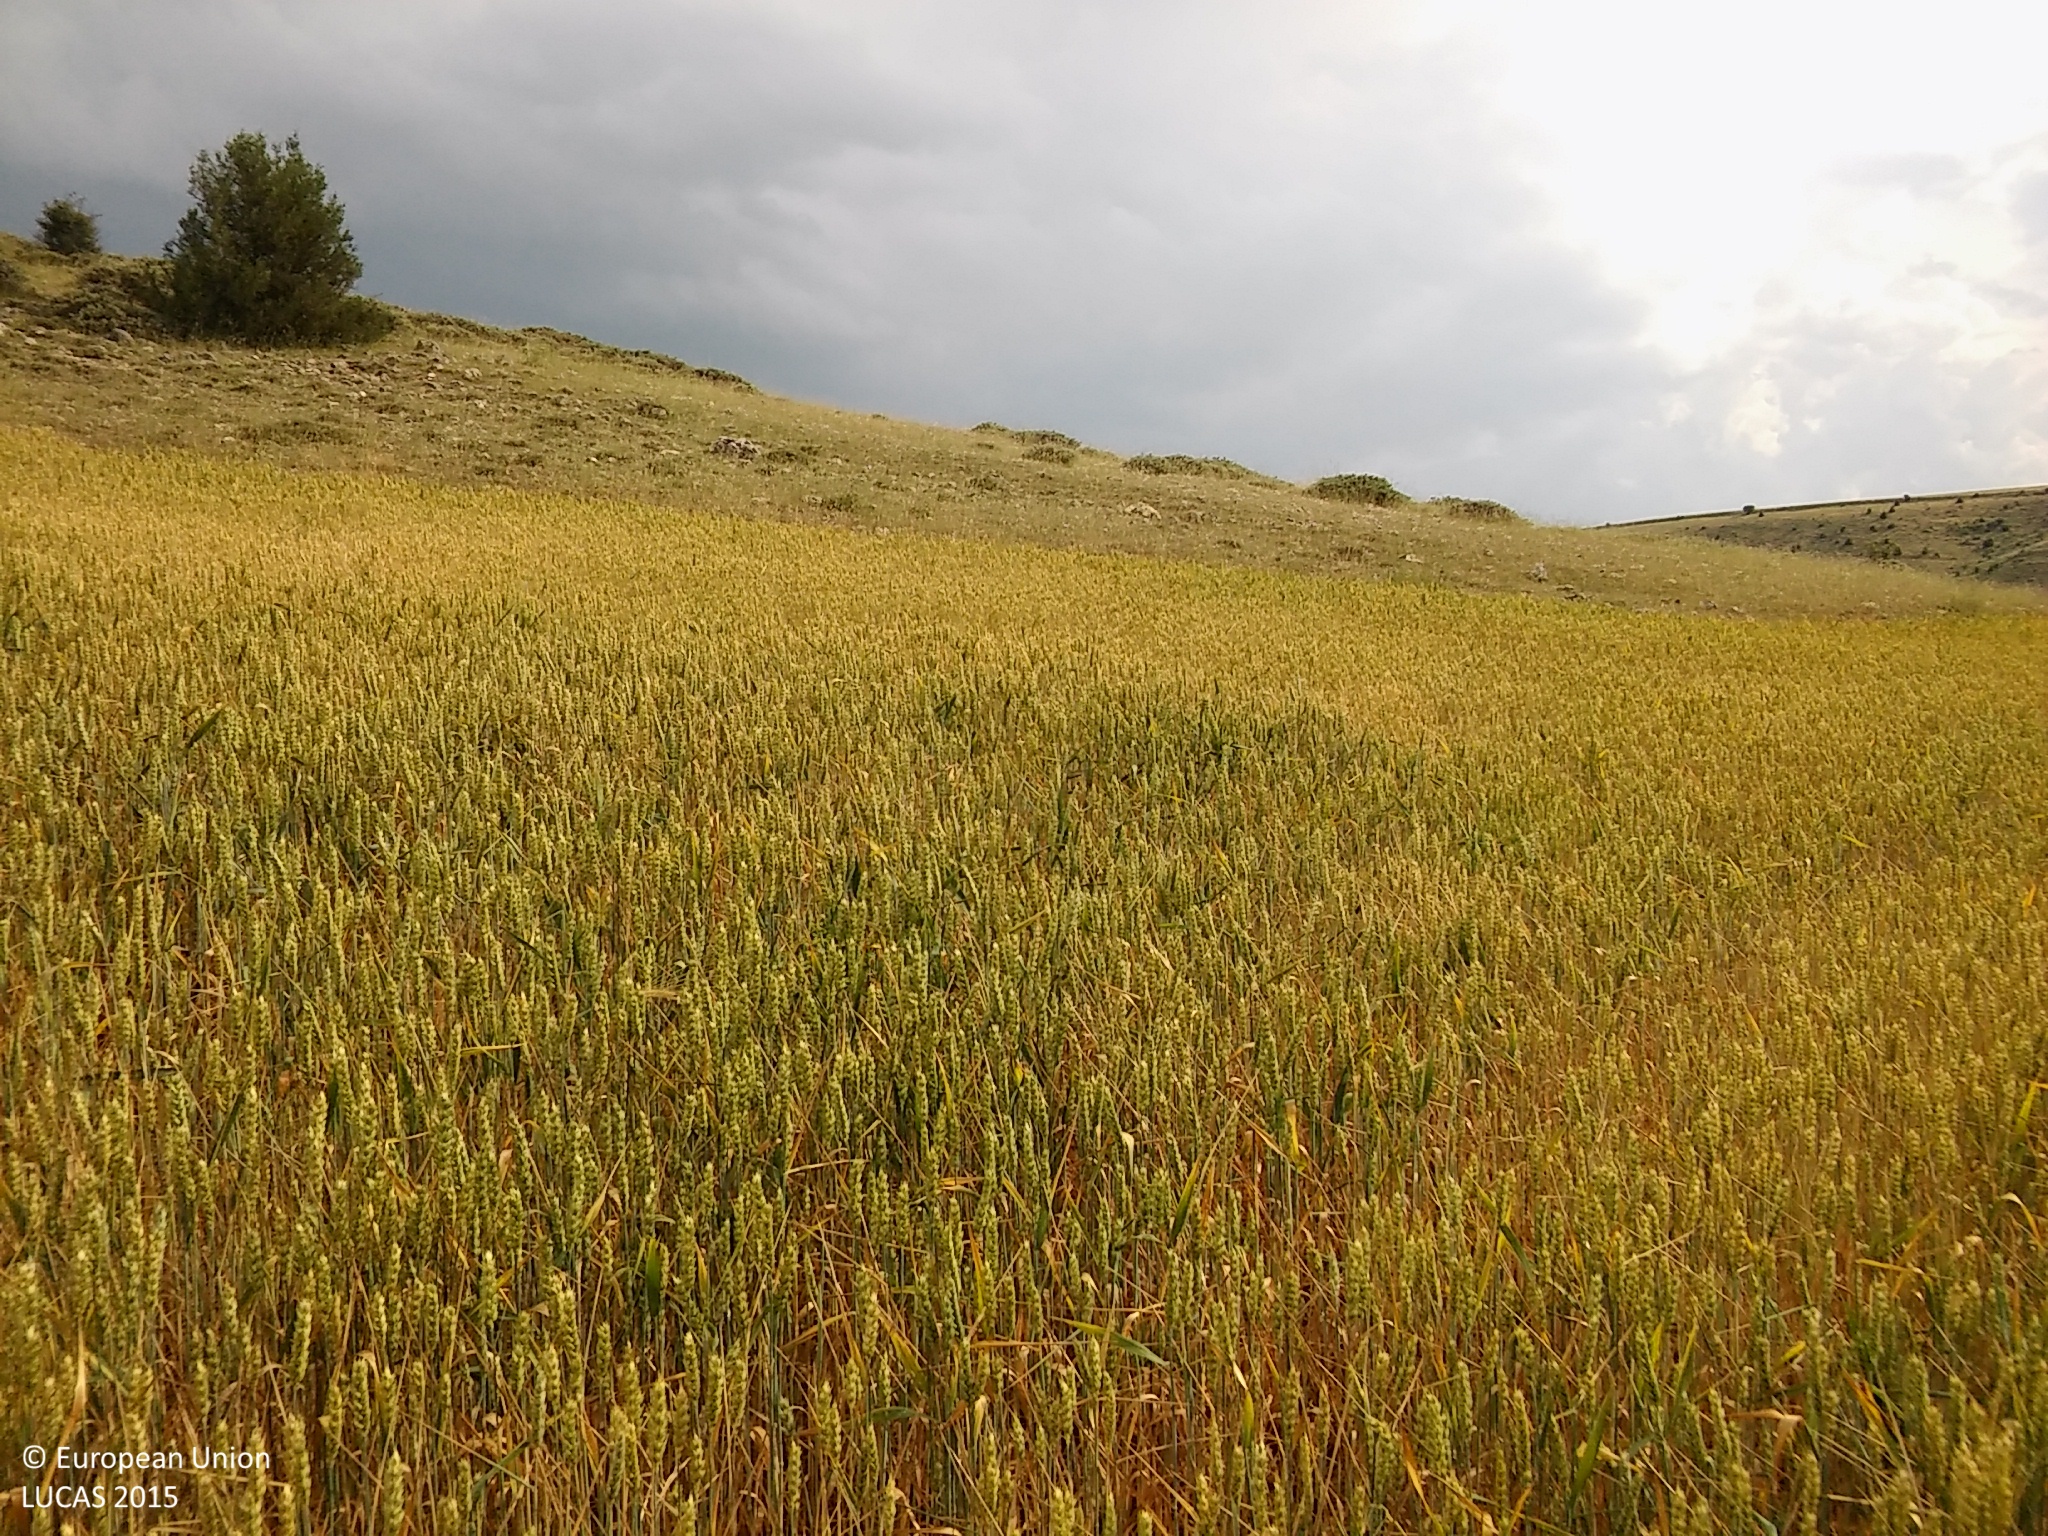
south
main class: Cropland
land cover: Common wheat
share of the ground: > 75 %
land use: Agriculture (excluding fallow land and kitchen gardens)
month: June
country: ES
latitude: 41.2023
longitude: -3.7257
